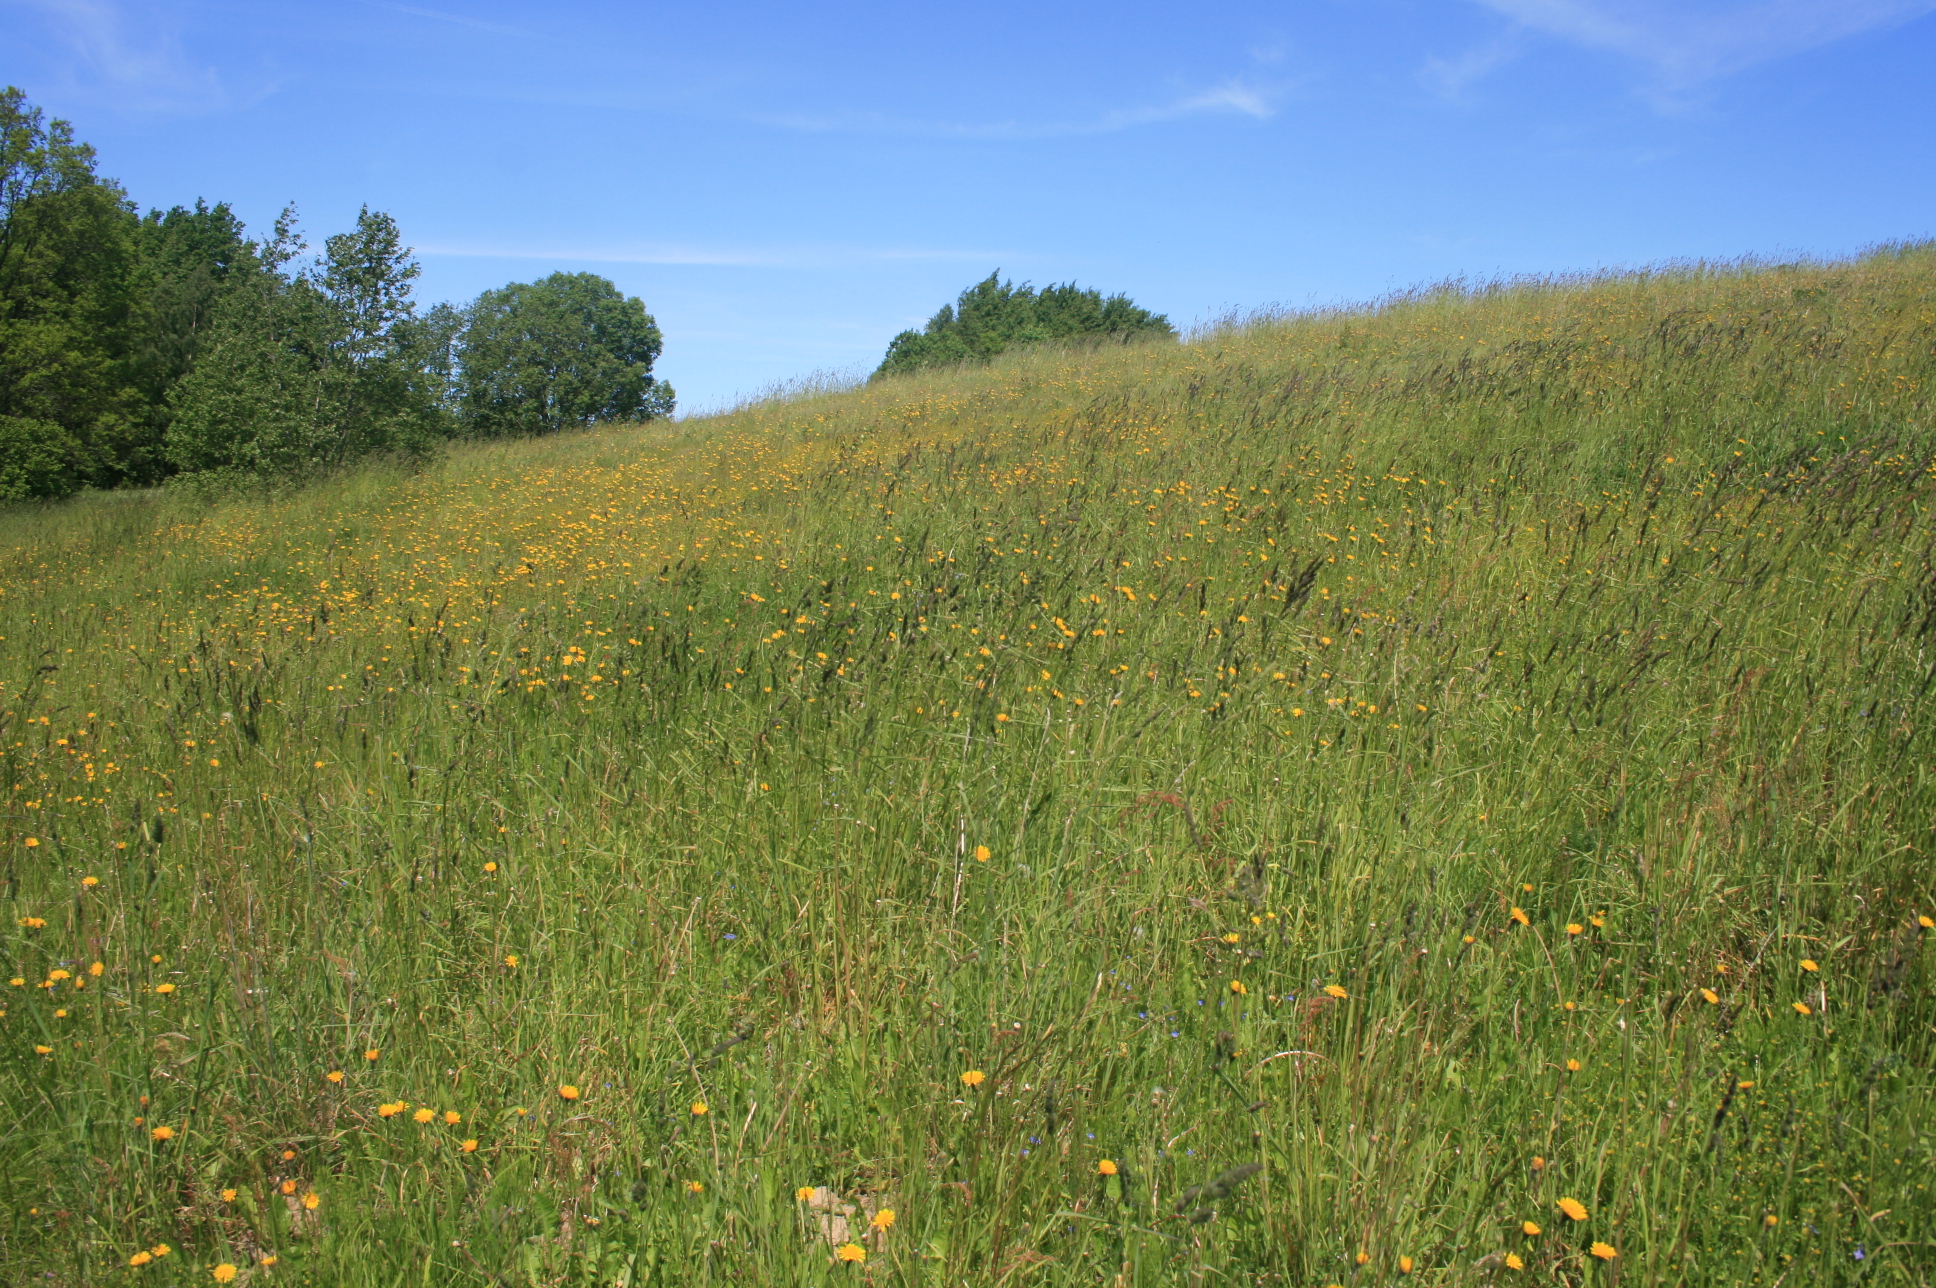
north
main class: Grassland
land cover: Grassland without tree/shrub cover
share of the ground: > 75 %
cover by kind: herbaceous plants 100 %
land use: Agriculture (excluding fallow land and kitchen gardens)
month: June
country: LT
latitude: 55.9005
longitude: 22.3238
